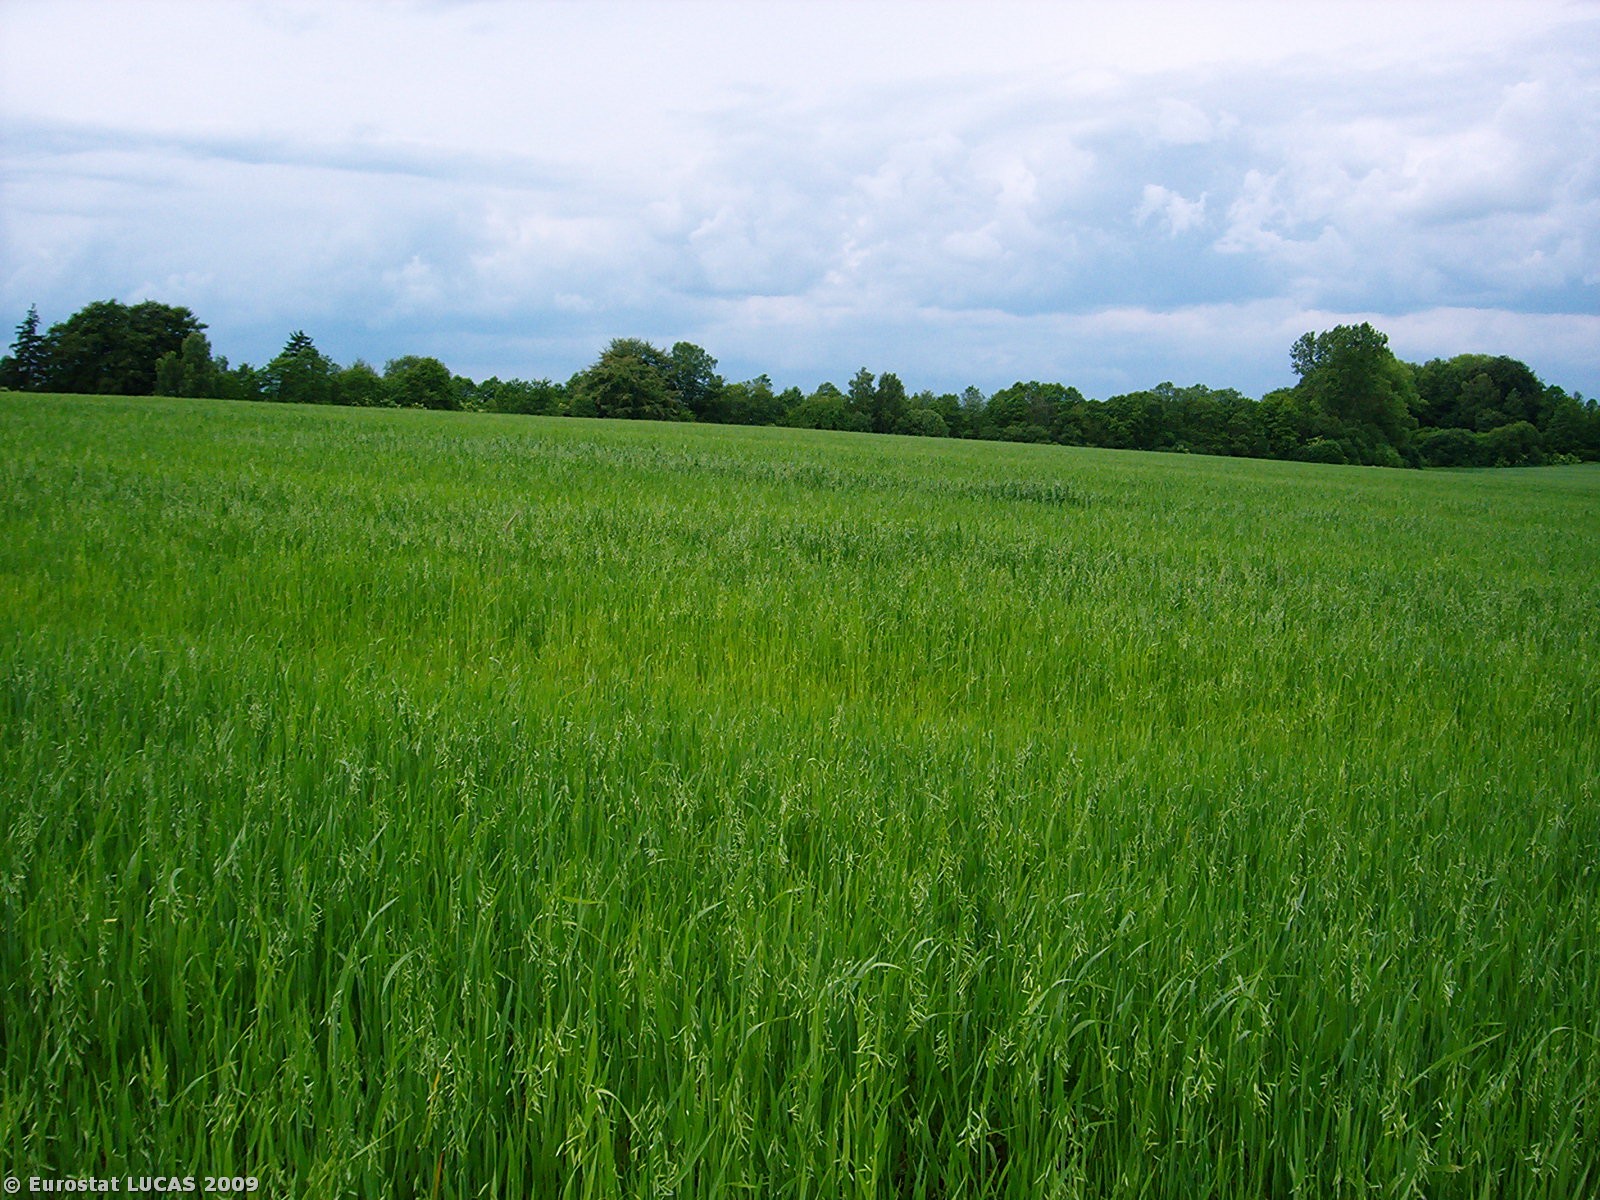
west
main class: Cropland
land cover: Oats
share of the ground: > 75 %
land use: Agriculture (excluding fallow land and kitchen gardens)
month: June
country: PL
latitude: 53.6230
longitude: 17.1612
